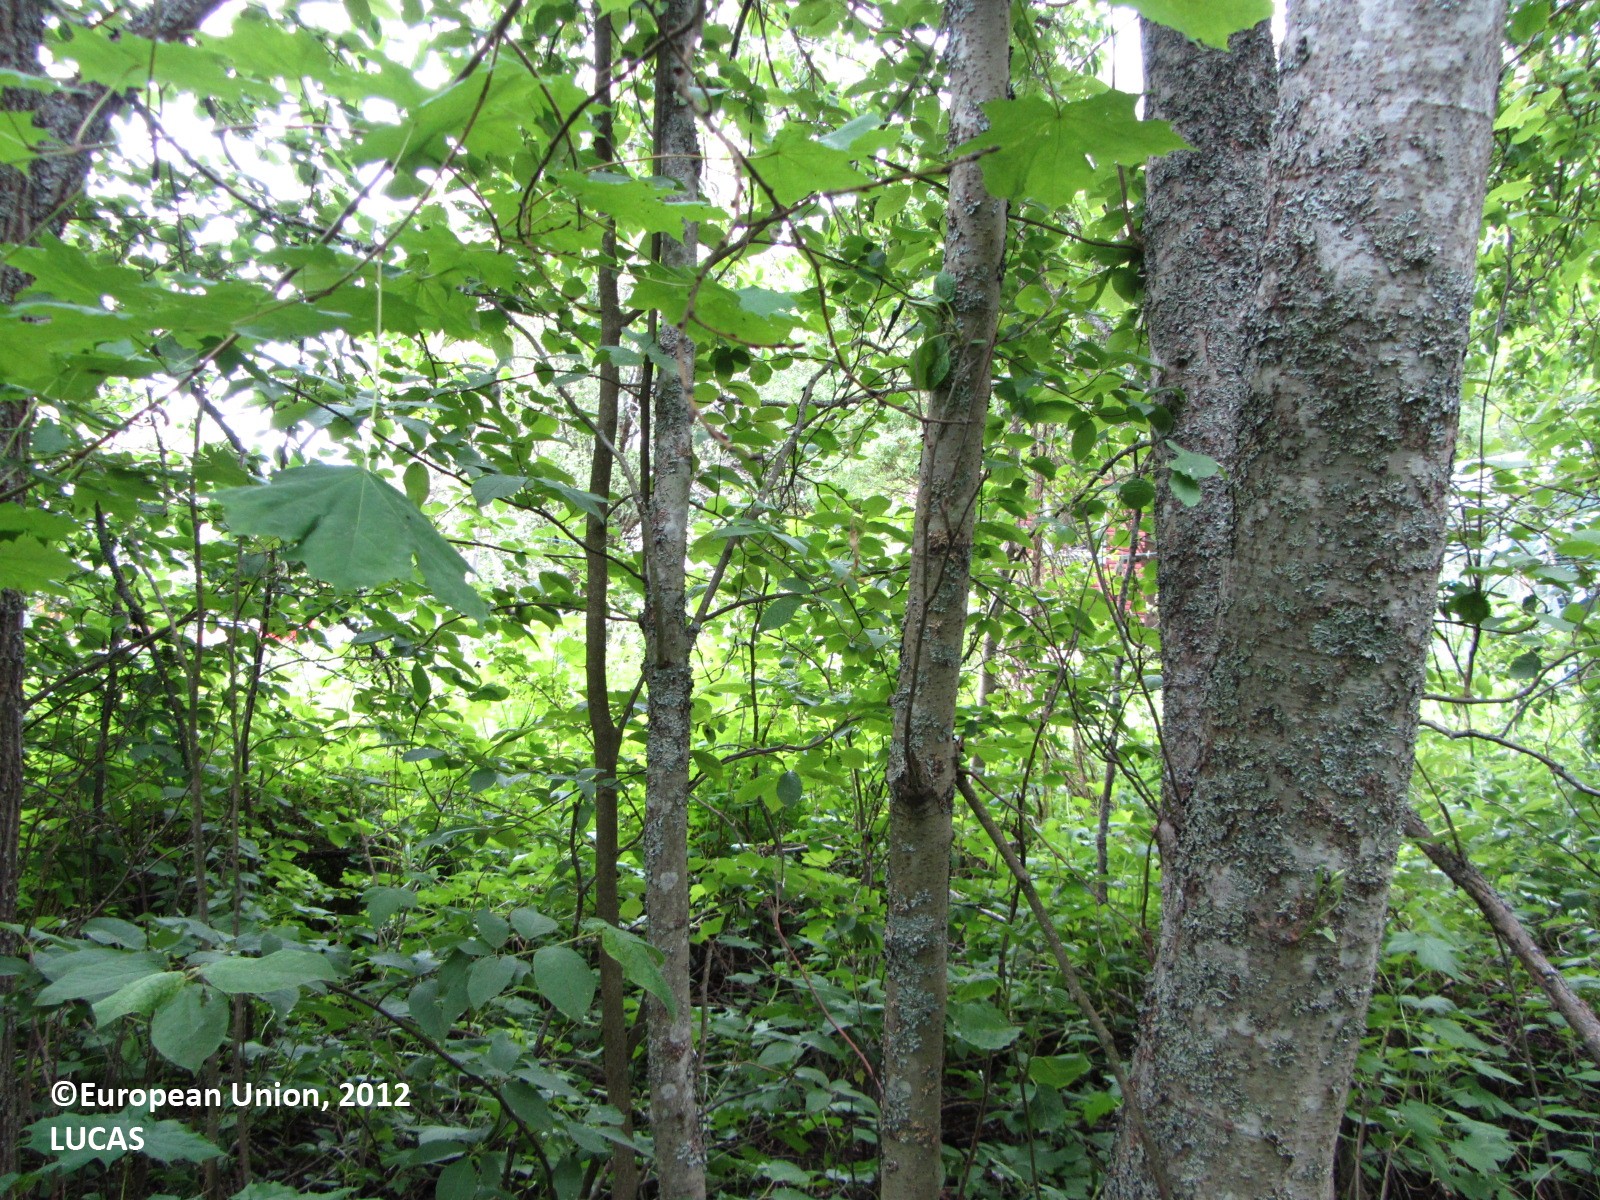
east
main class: Woodland
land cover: Broadleaved woodland
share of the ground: 50 - 75 %
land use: Semi-natural and natural areas not in use
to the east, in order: Broadleaved woodland; Artificial constructions in urban areas
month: June
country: FI
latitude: 61.8583
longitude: 25.1429
